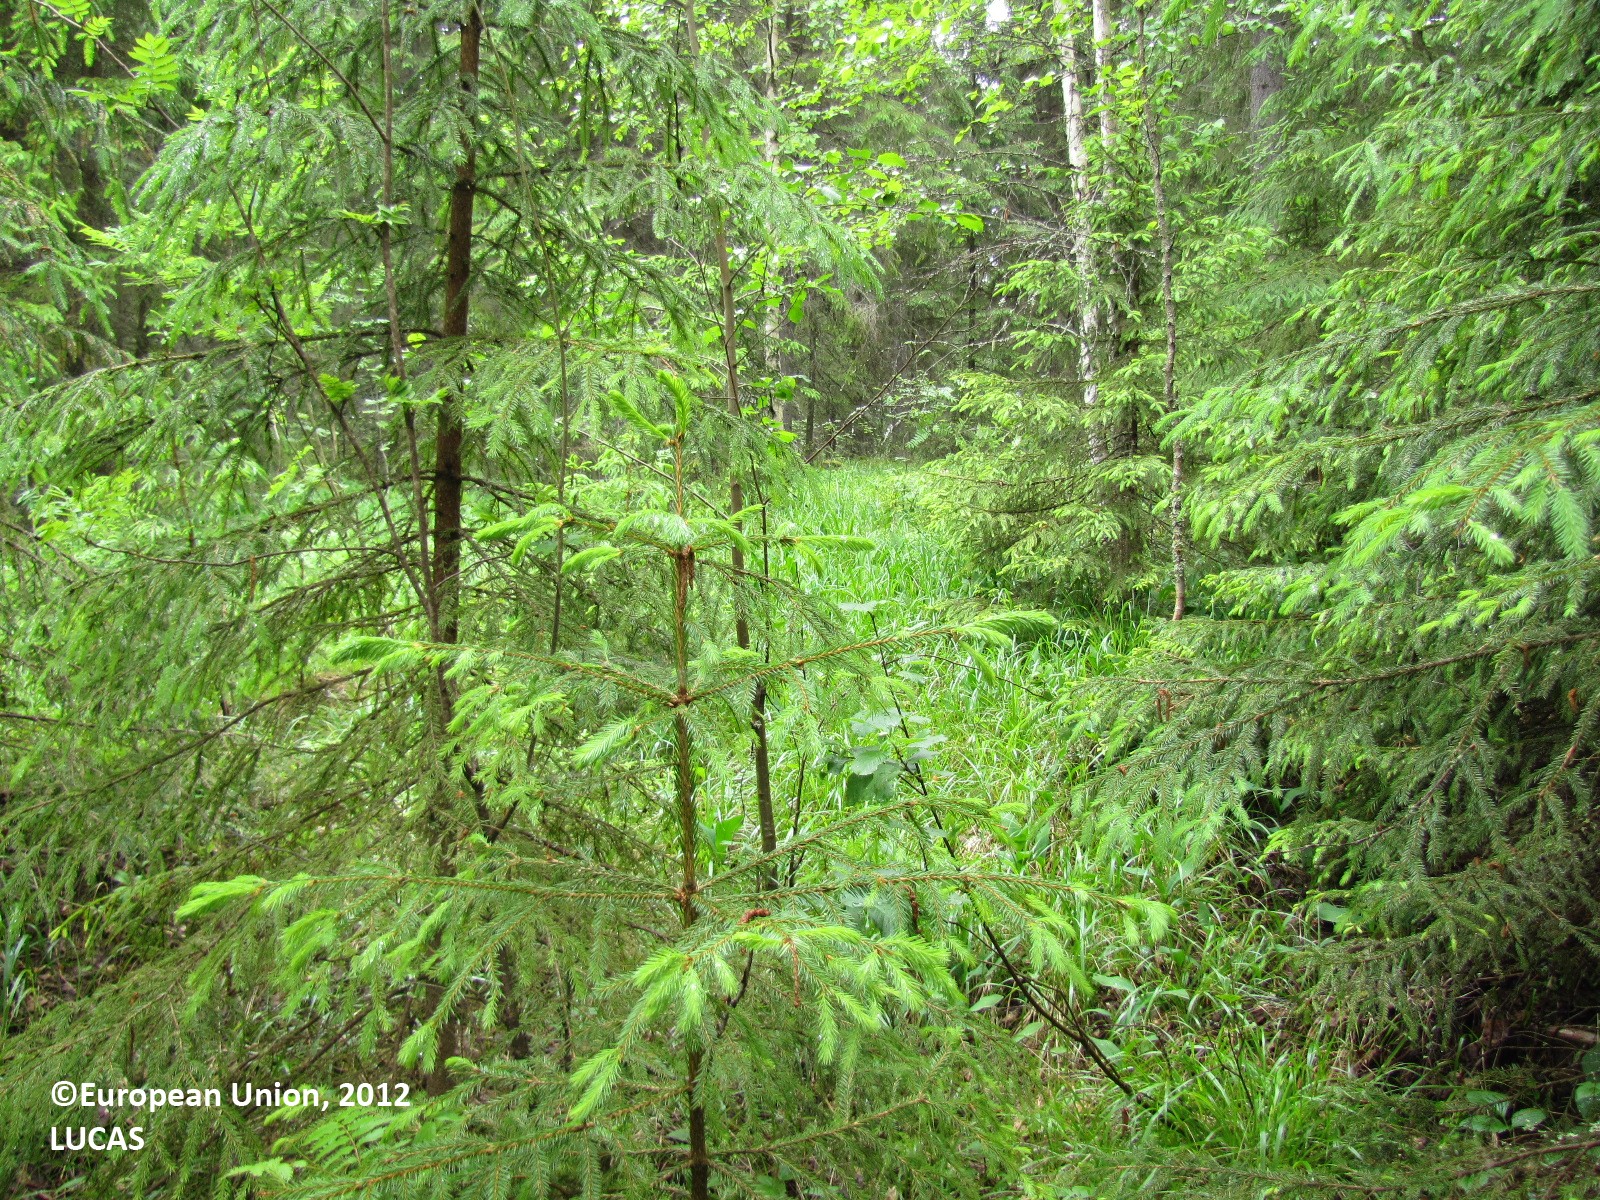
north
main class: Woodland
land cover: Spruce dominated coniferous woodland
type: boreal forest
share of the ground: 50 - 75 %
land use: Forestry
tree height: > 5 m
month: June
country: FI
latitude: 61.5516
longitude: 24.7244
